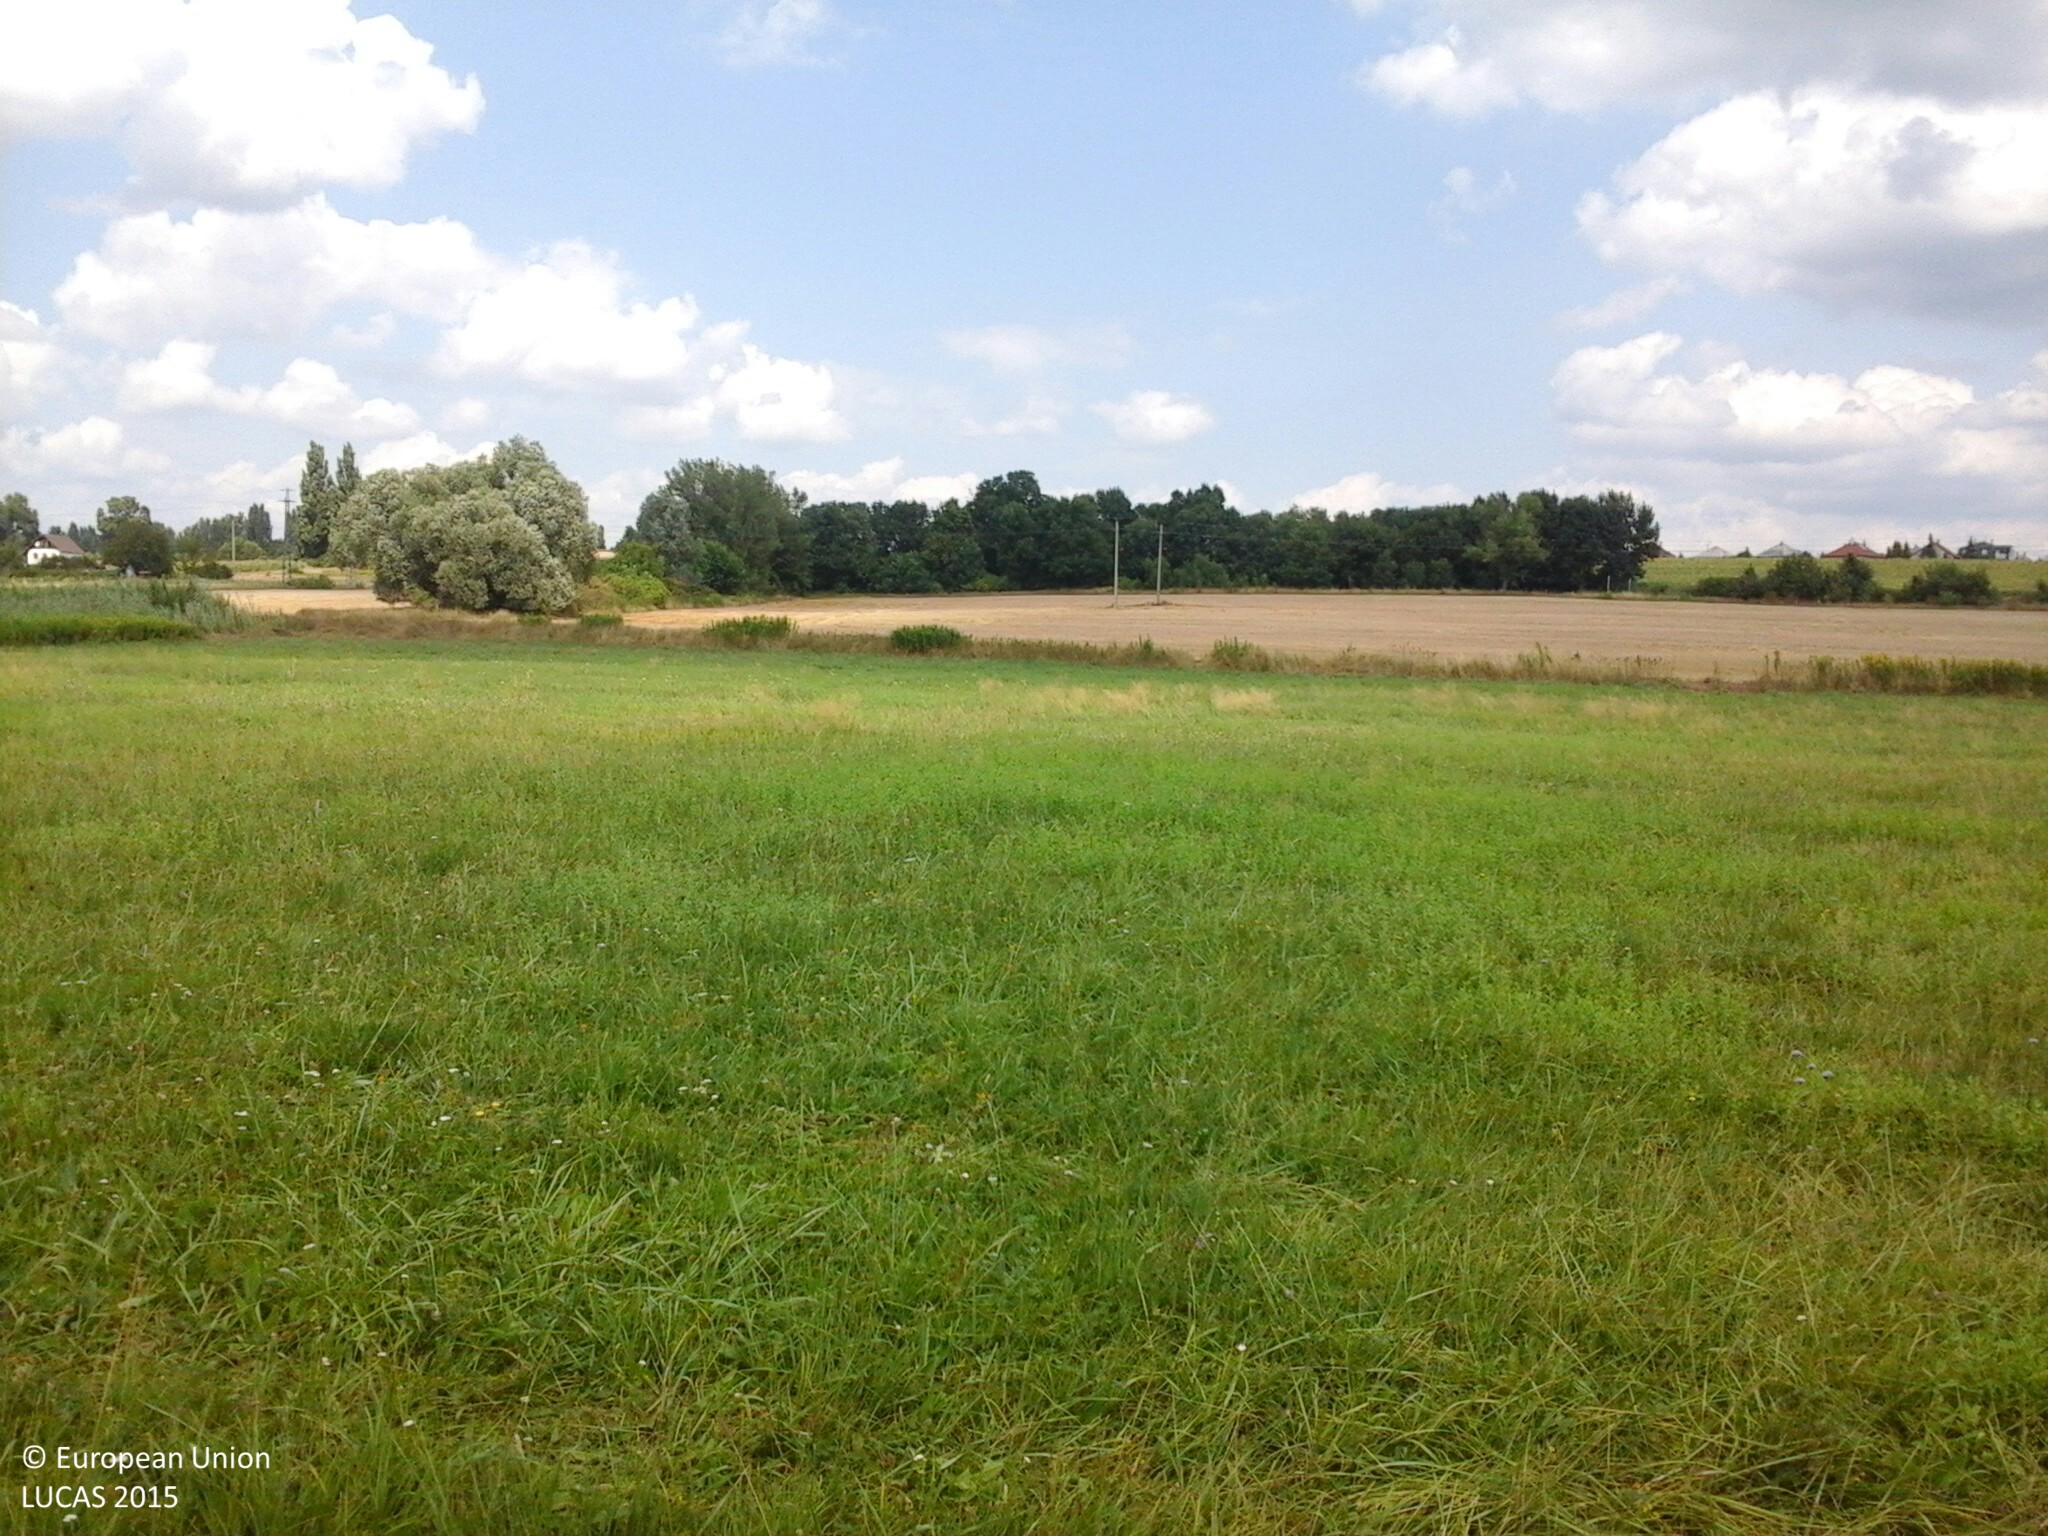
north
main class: Grassland
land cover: Grassland without tree/shrub cover
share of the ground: > 75 %
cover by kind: herbaceous plants 100 %
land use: Semi-natural and natural areas not in use
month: August
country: HU
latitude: 47.3565
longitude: 18.2066
